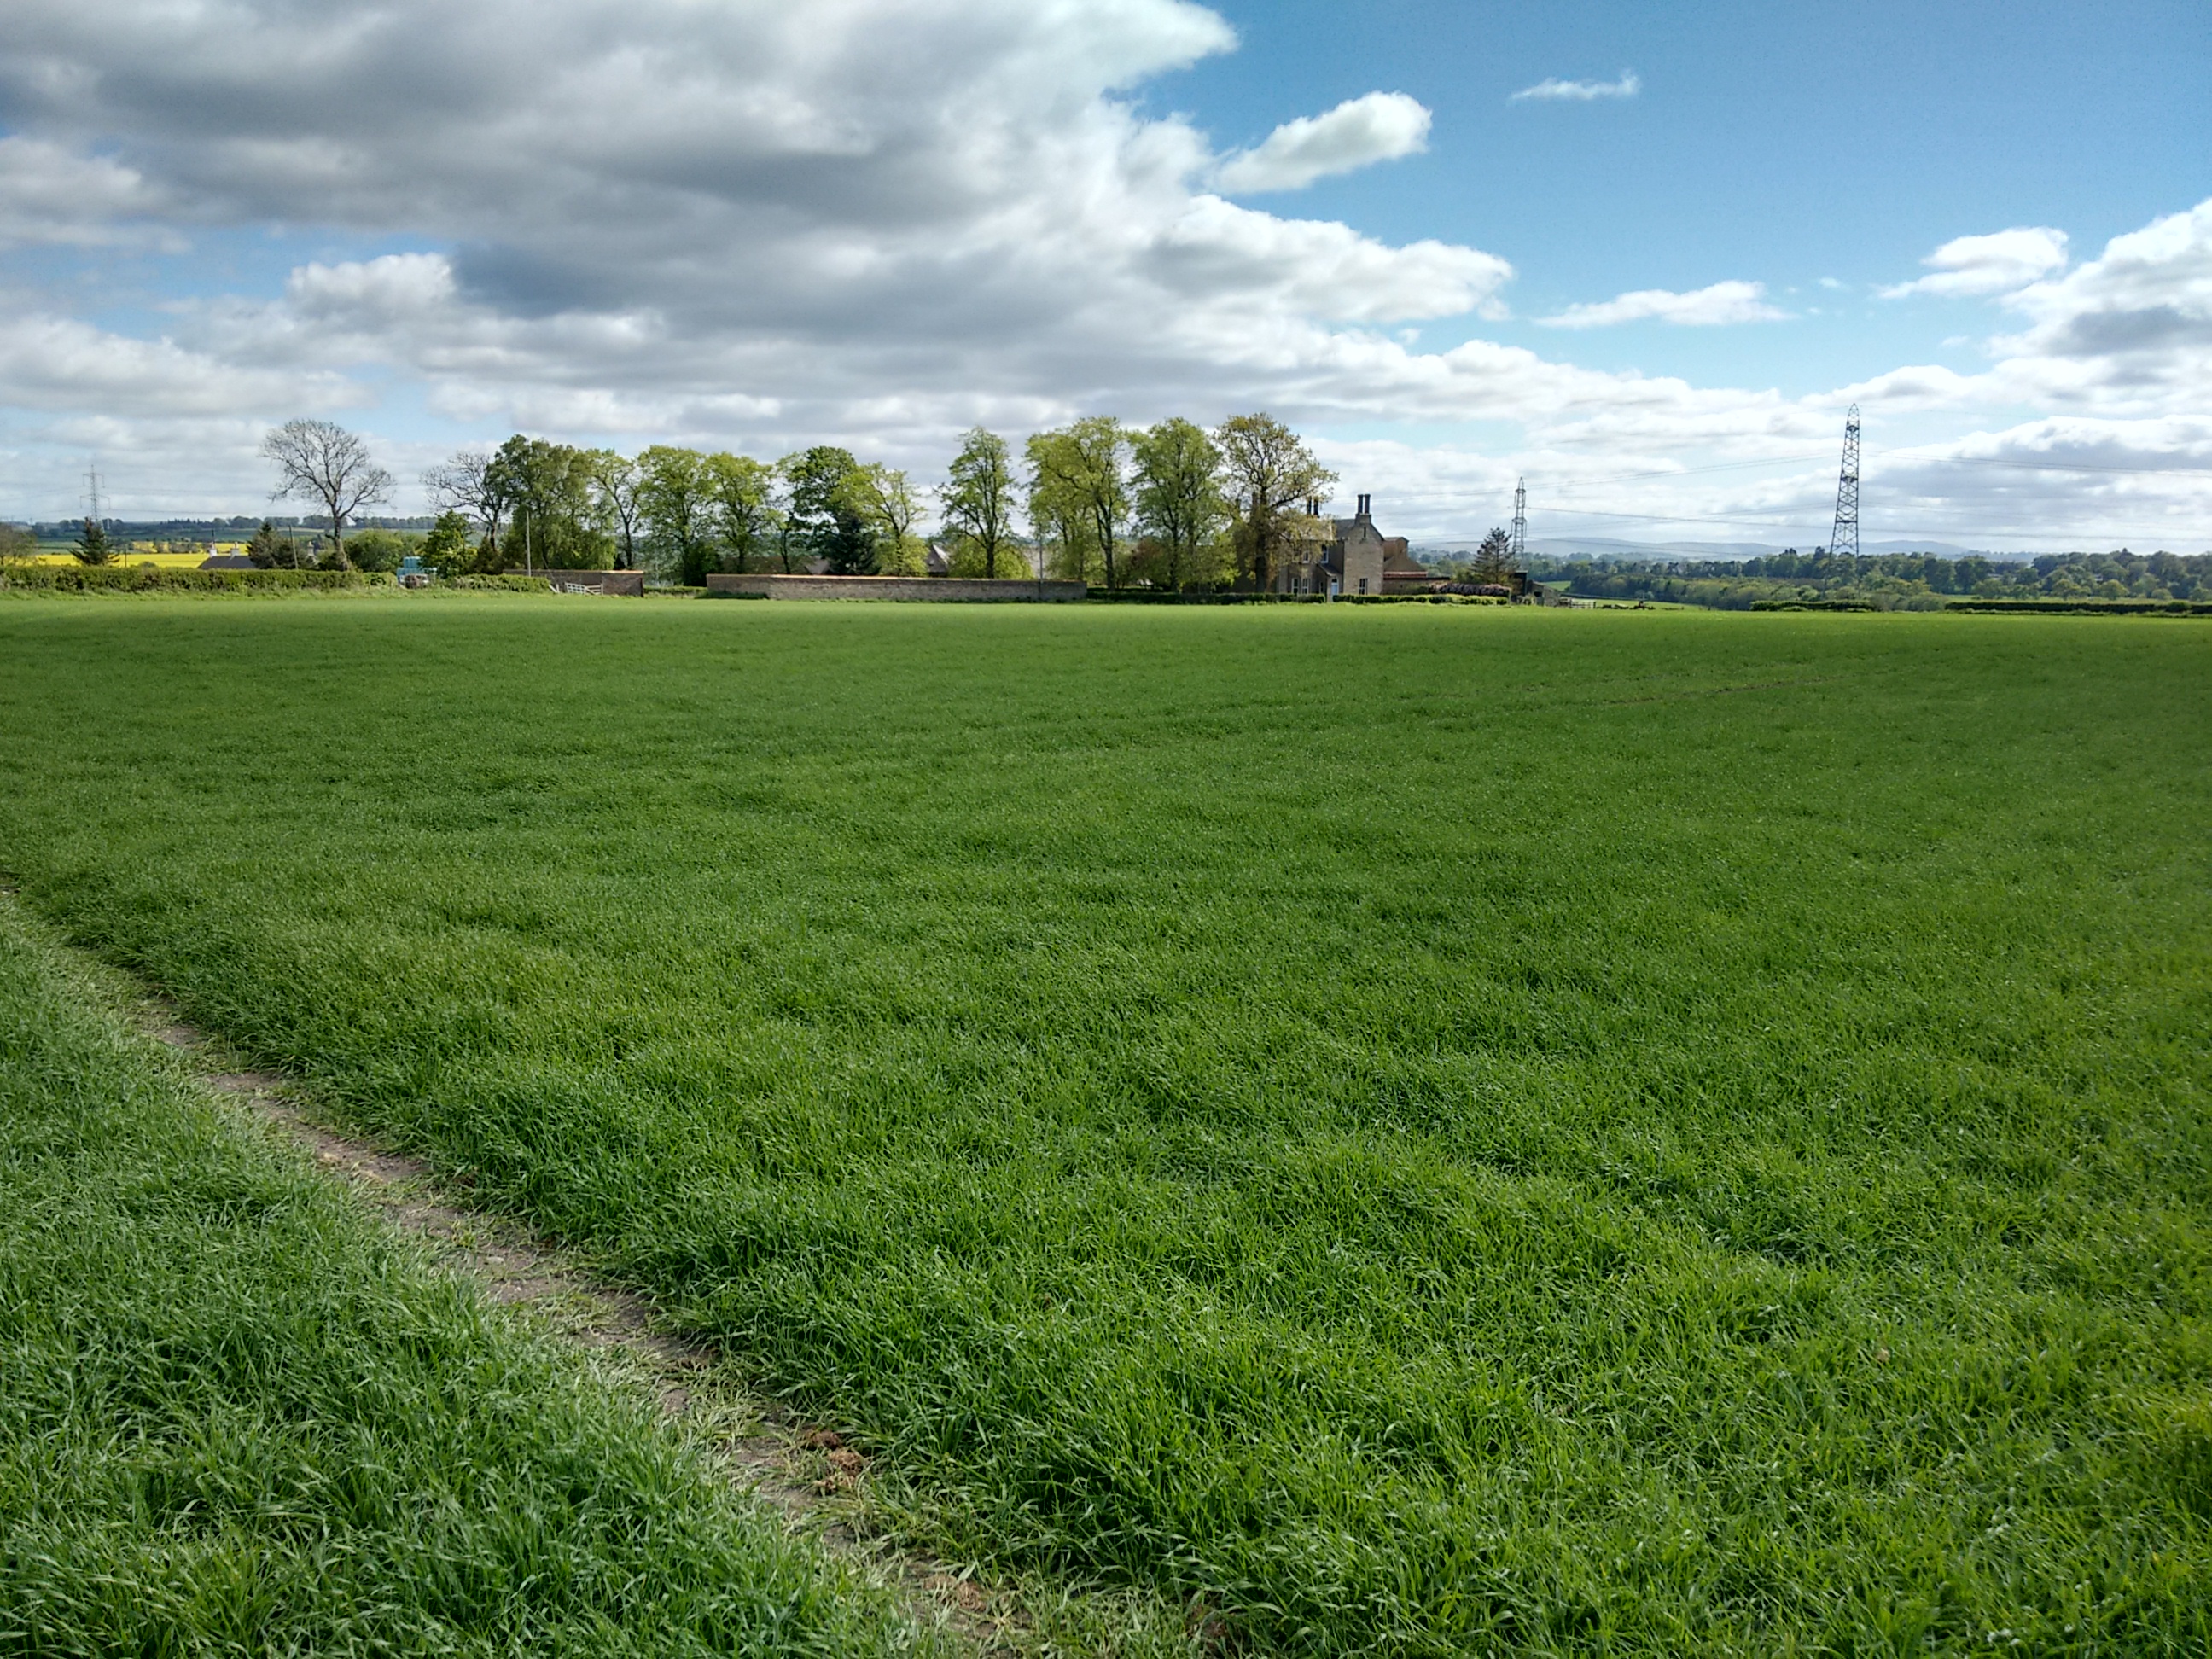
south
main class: Cropland
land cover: Barley
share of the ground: > 75 %
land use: Agriculture (excluding fallow land and kitchen gardens)
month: May
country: GB
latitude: 55.8937
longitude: -2.9398
